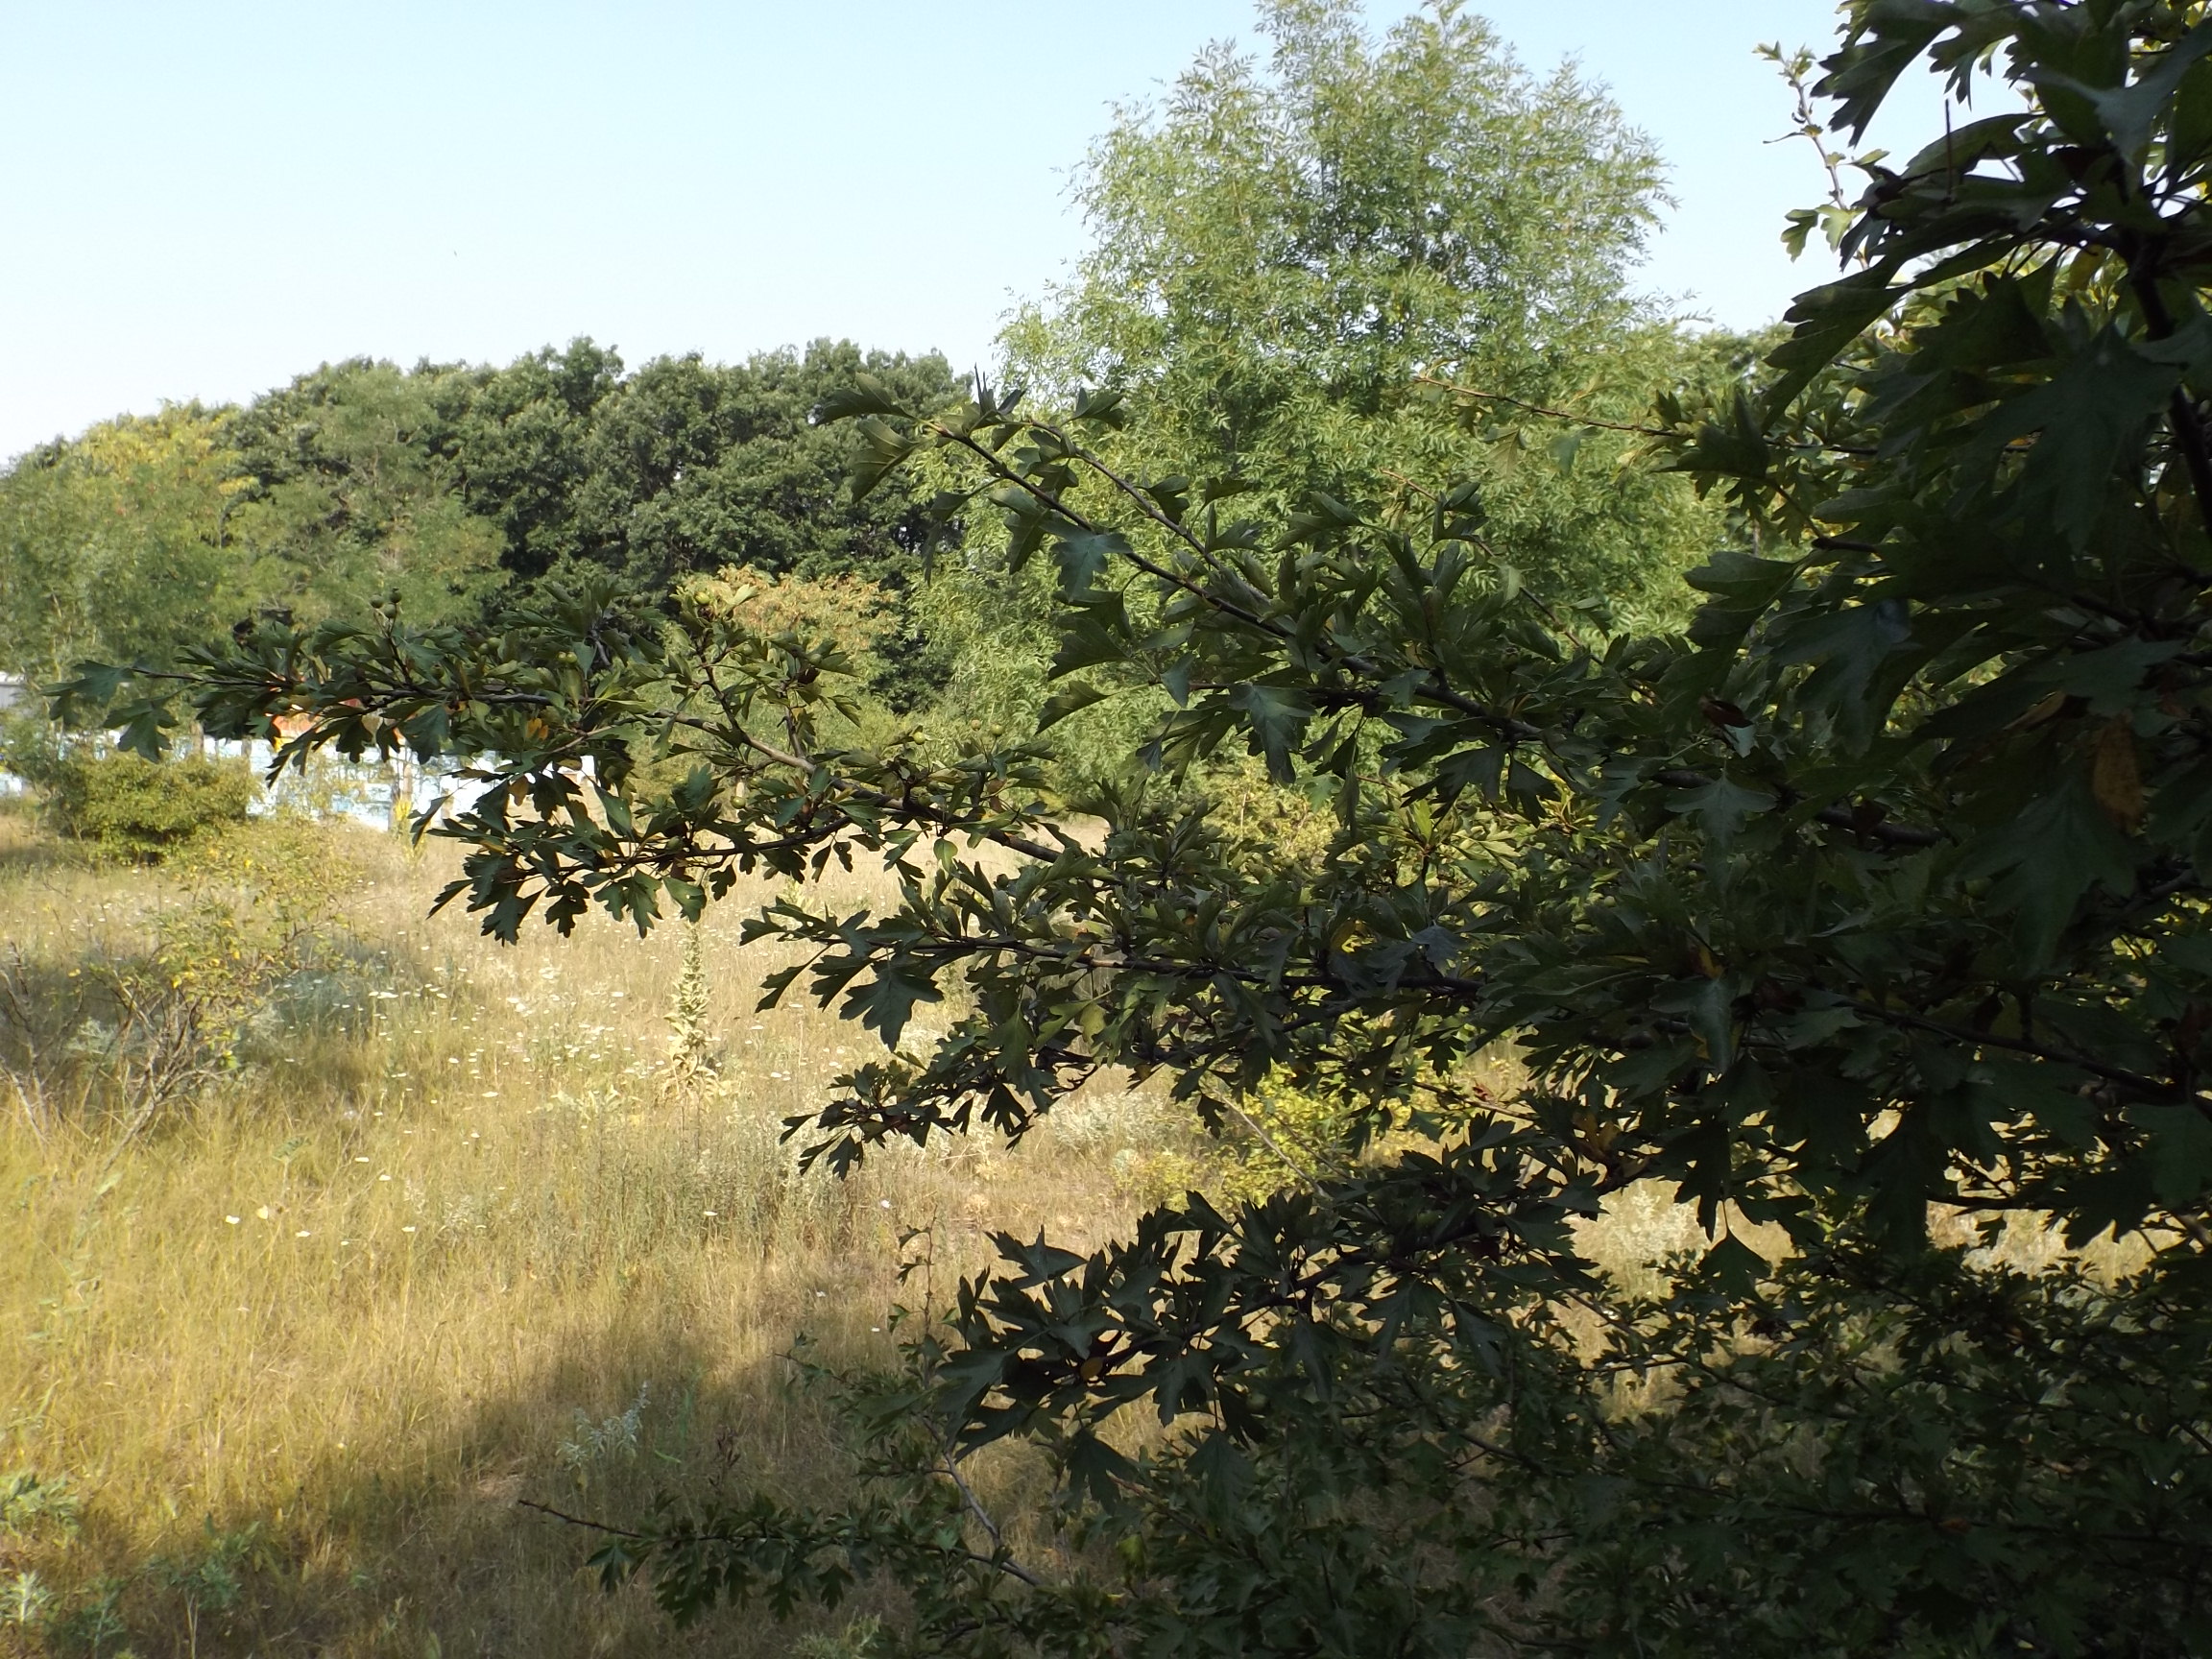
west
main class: Woodland
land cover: Broadleaved woodland
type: mesophytic deciduous forest
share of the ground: 50 - 75 %
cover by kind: broadleaved forest trees 60 %, herbaceous plants 30 %, shrubs 10 %
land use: Forestry
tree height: > 5 m
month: July
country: BG
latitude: 43.4938
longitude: 27.6075
